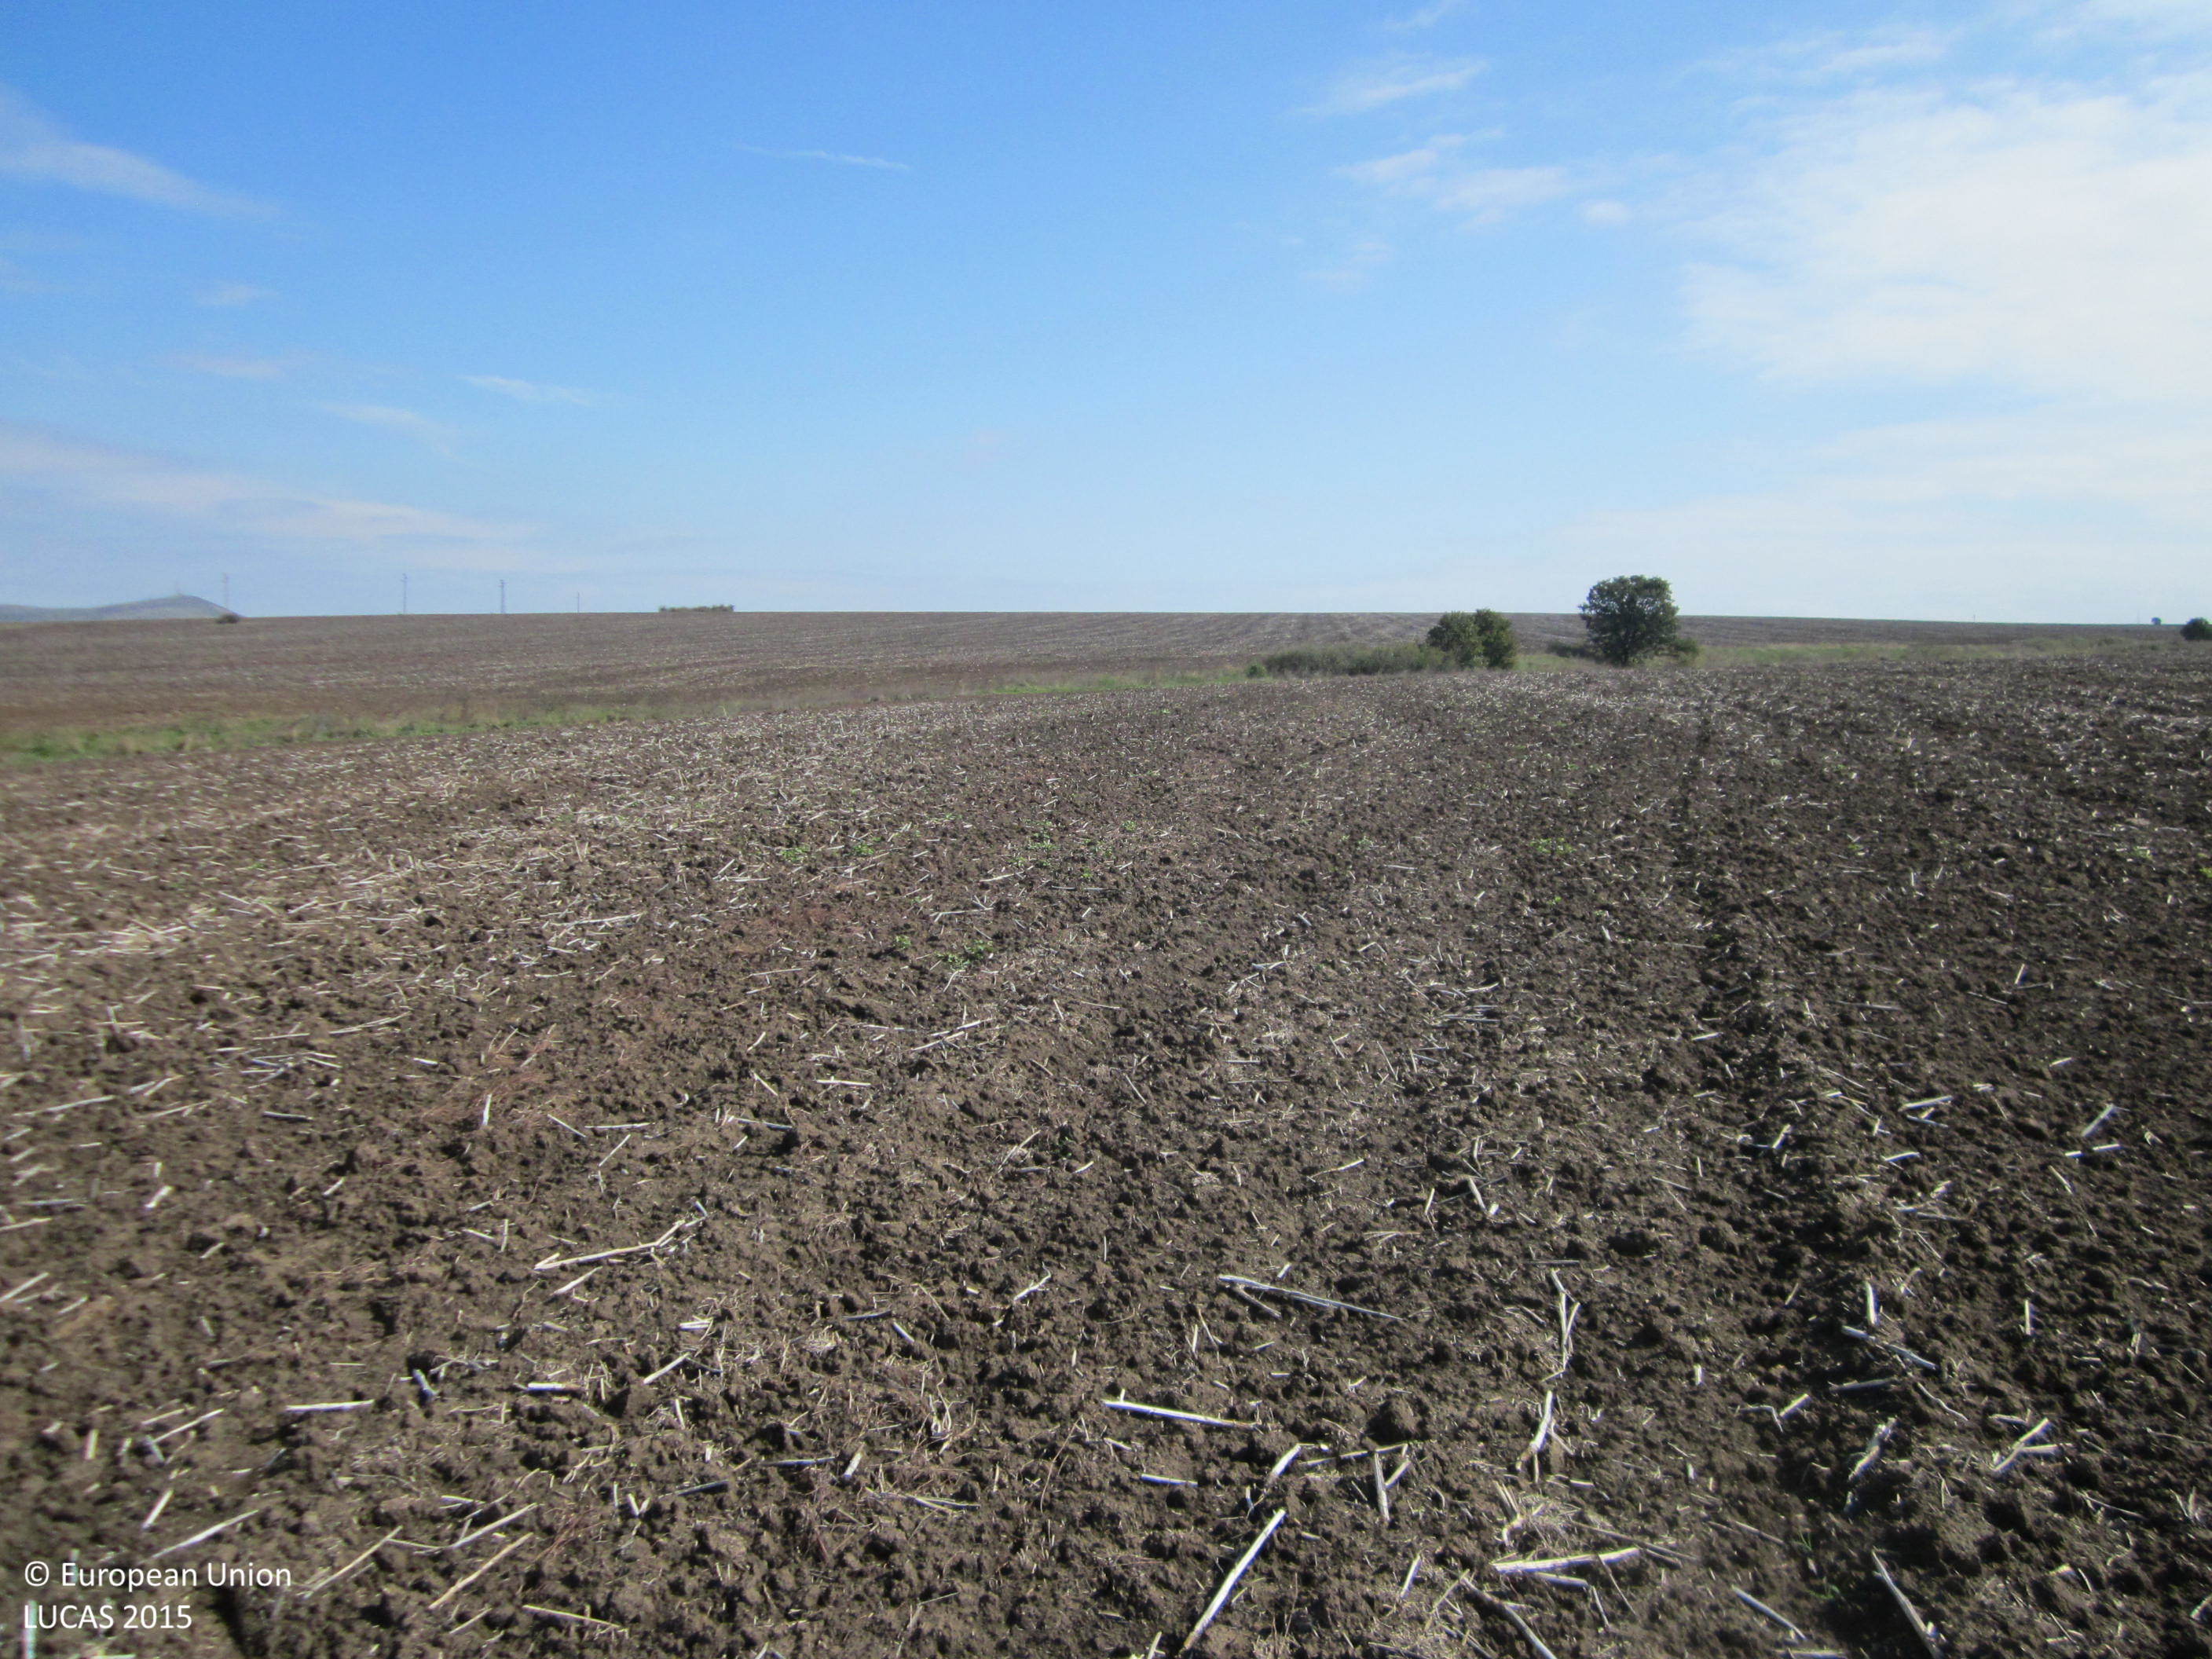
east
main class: Cropland
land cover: Sunflower
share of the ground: < 10 %
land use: Agriculture (excluding fallow land and kitchen gardens)
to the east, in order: Sunflower; Grass margins; Ditches and canals; Grass margins; Single bushes/trees; Grass margins; Sunflower
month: October
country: BG
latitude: 42.6006
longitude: 26.9111
